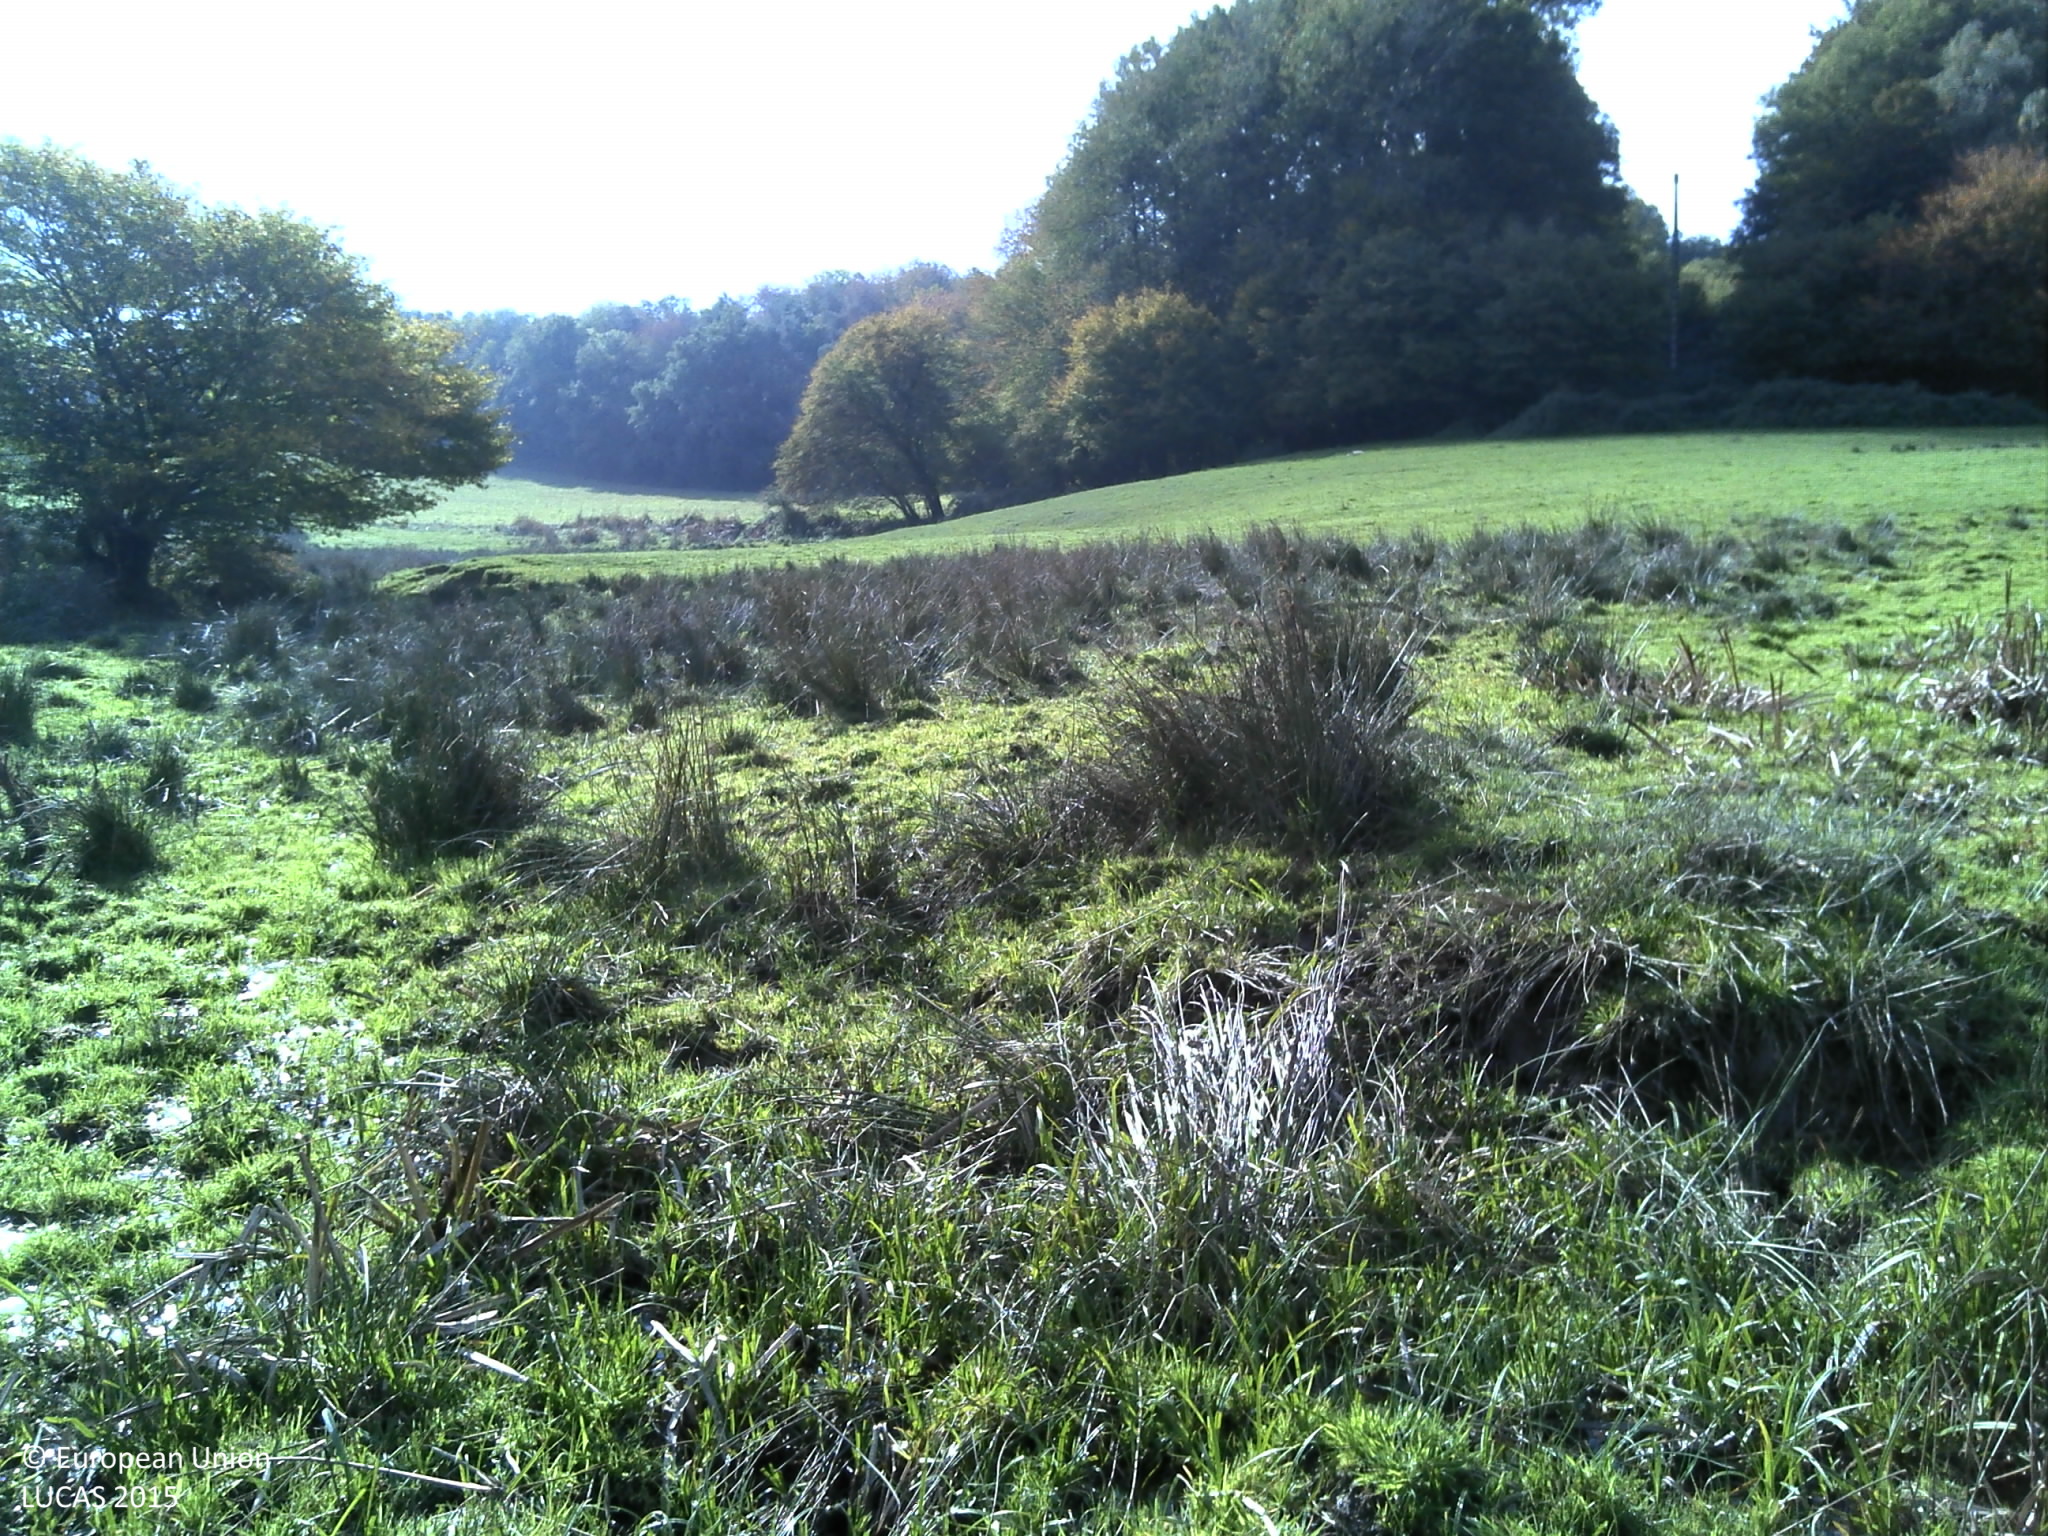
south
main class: Shrubland
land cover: Shrubland without tree cover
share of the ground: > 75 %
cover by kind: shrubs 50 %, herbaceous plants 50 %
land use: Agriculture (excluding fallow land and kitchen gardens)
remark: Temporary flooded
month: October
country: FR
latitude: 46.6330
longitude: 3.9782
